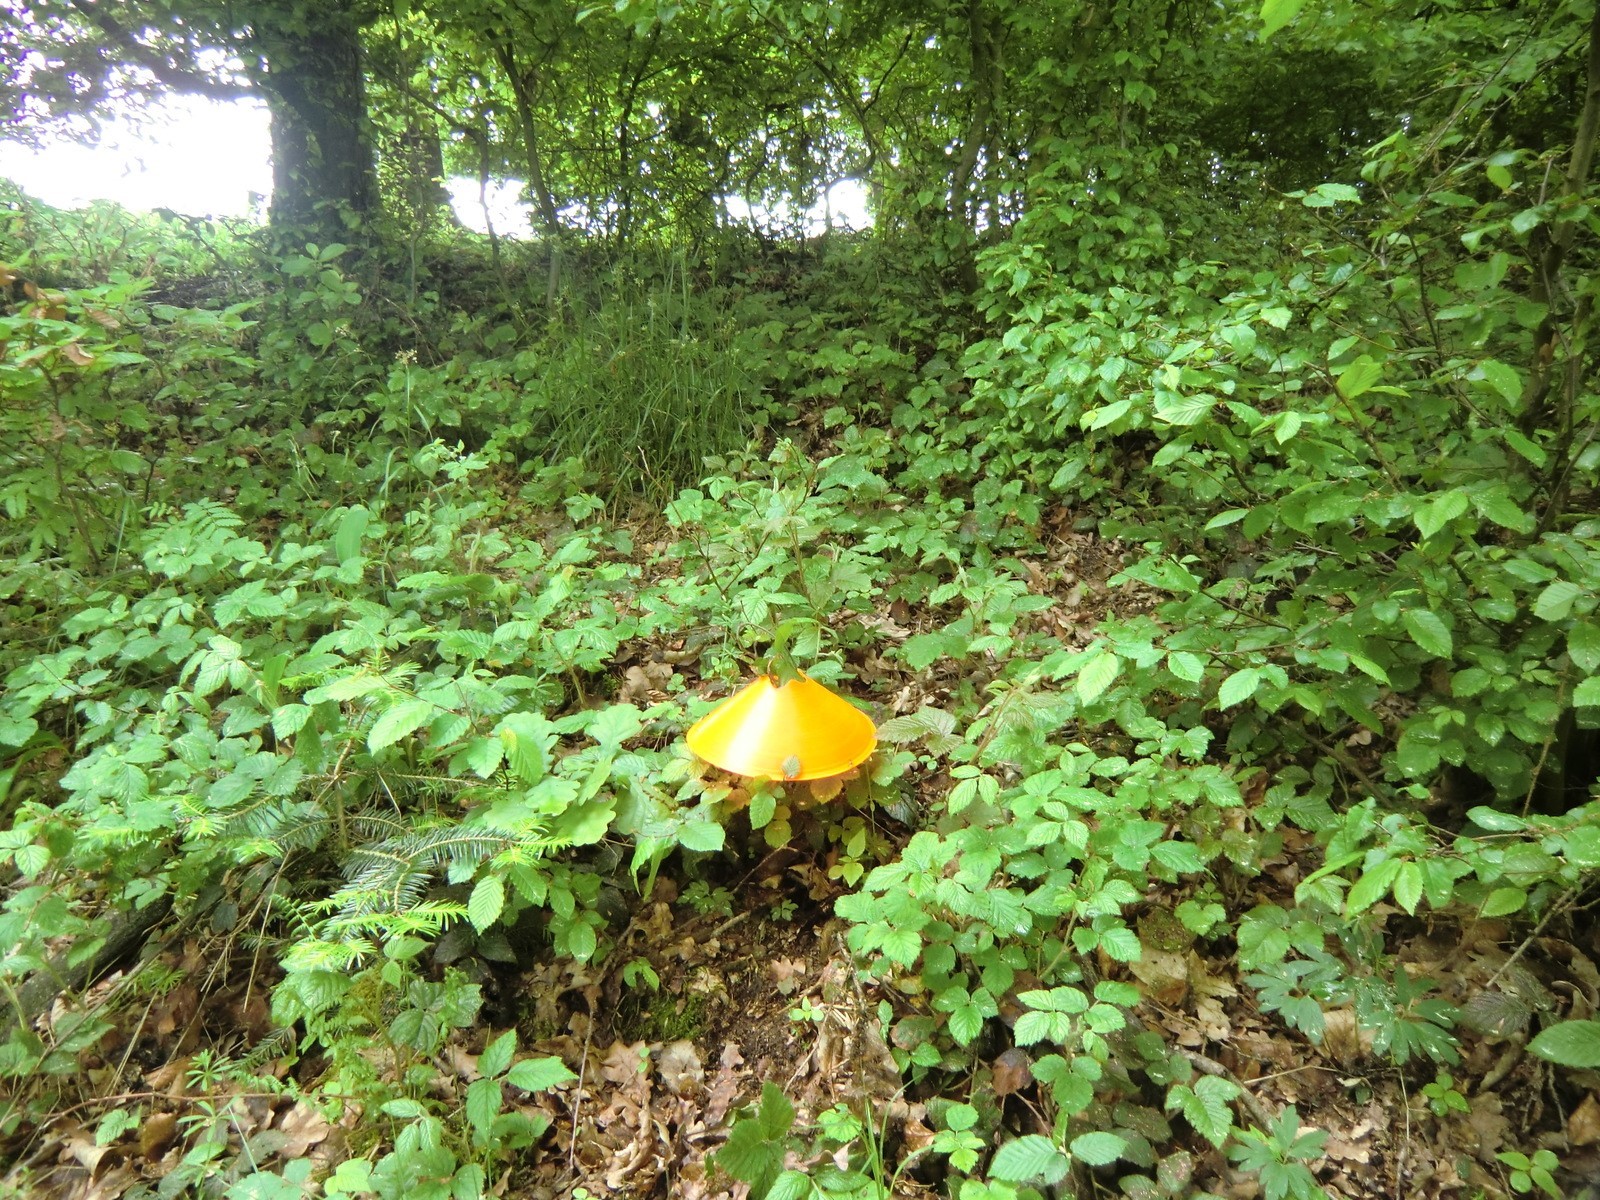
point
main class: Woodland
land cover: Spruce dominated mixed woodland
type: mountainous beech forest
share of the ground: > 75 %
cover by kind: broadleaved forest trees 30 %, shrubs 30 %, coniferous forest trees 20 %, herbaceous plants 10 %, unconsolidated bare surface 10 %
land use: Forestry
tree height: > 5 m
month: May
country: AT
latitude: 48.2709
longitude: 14.6219
